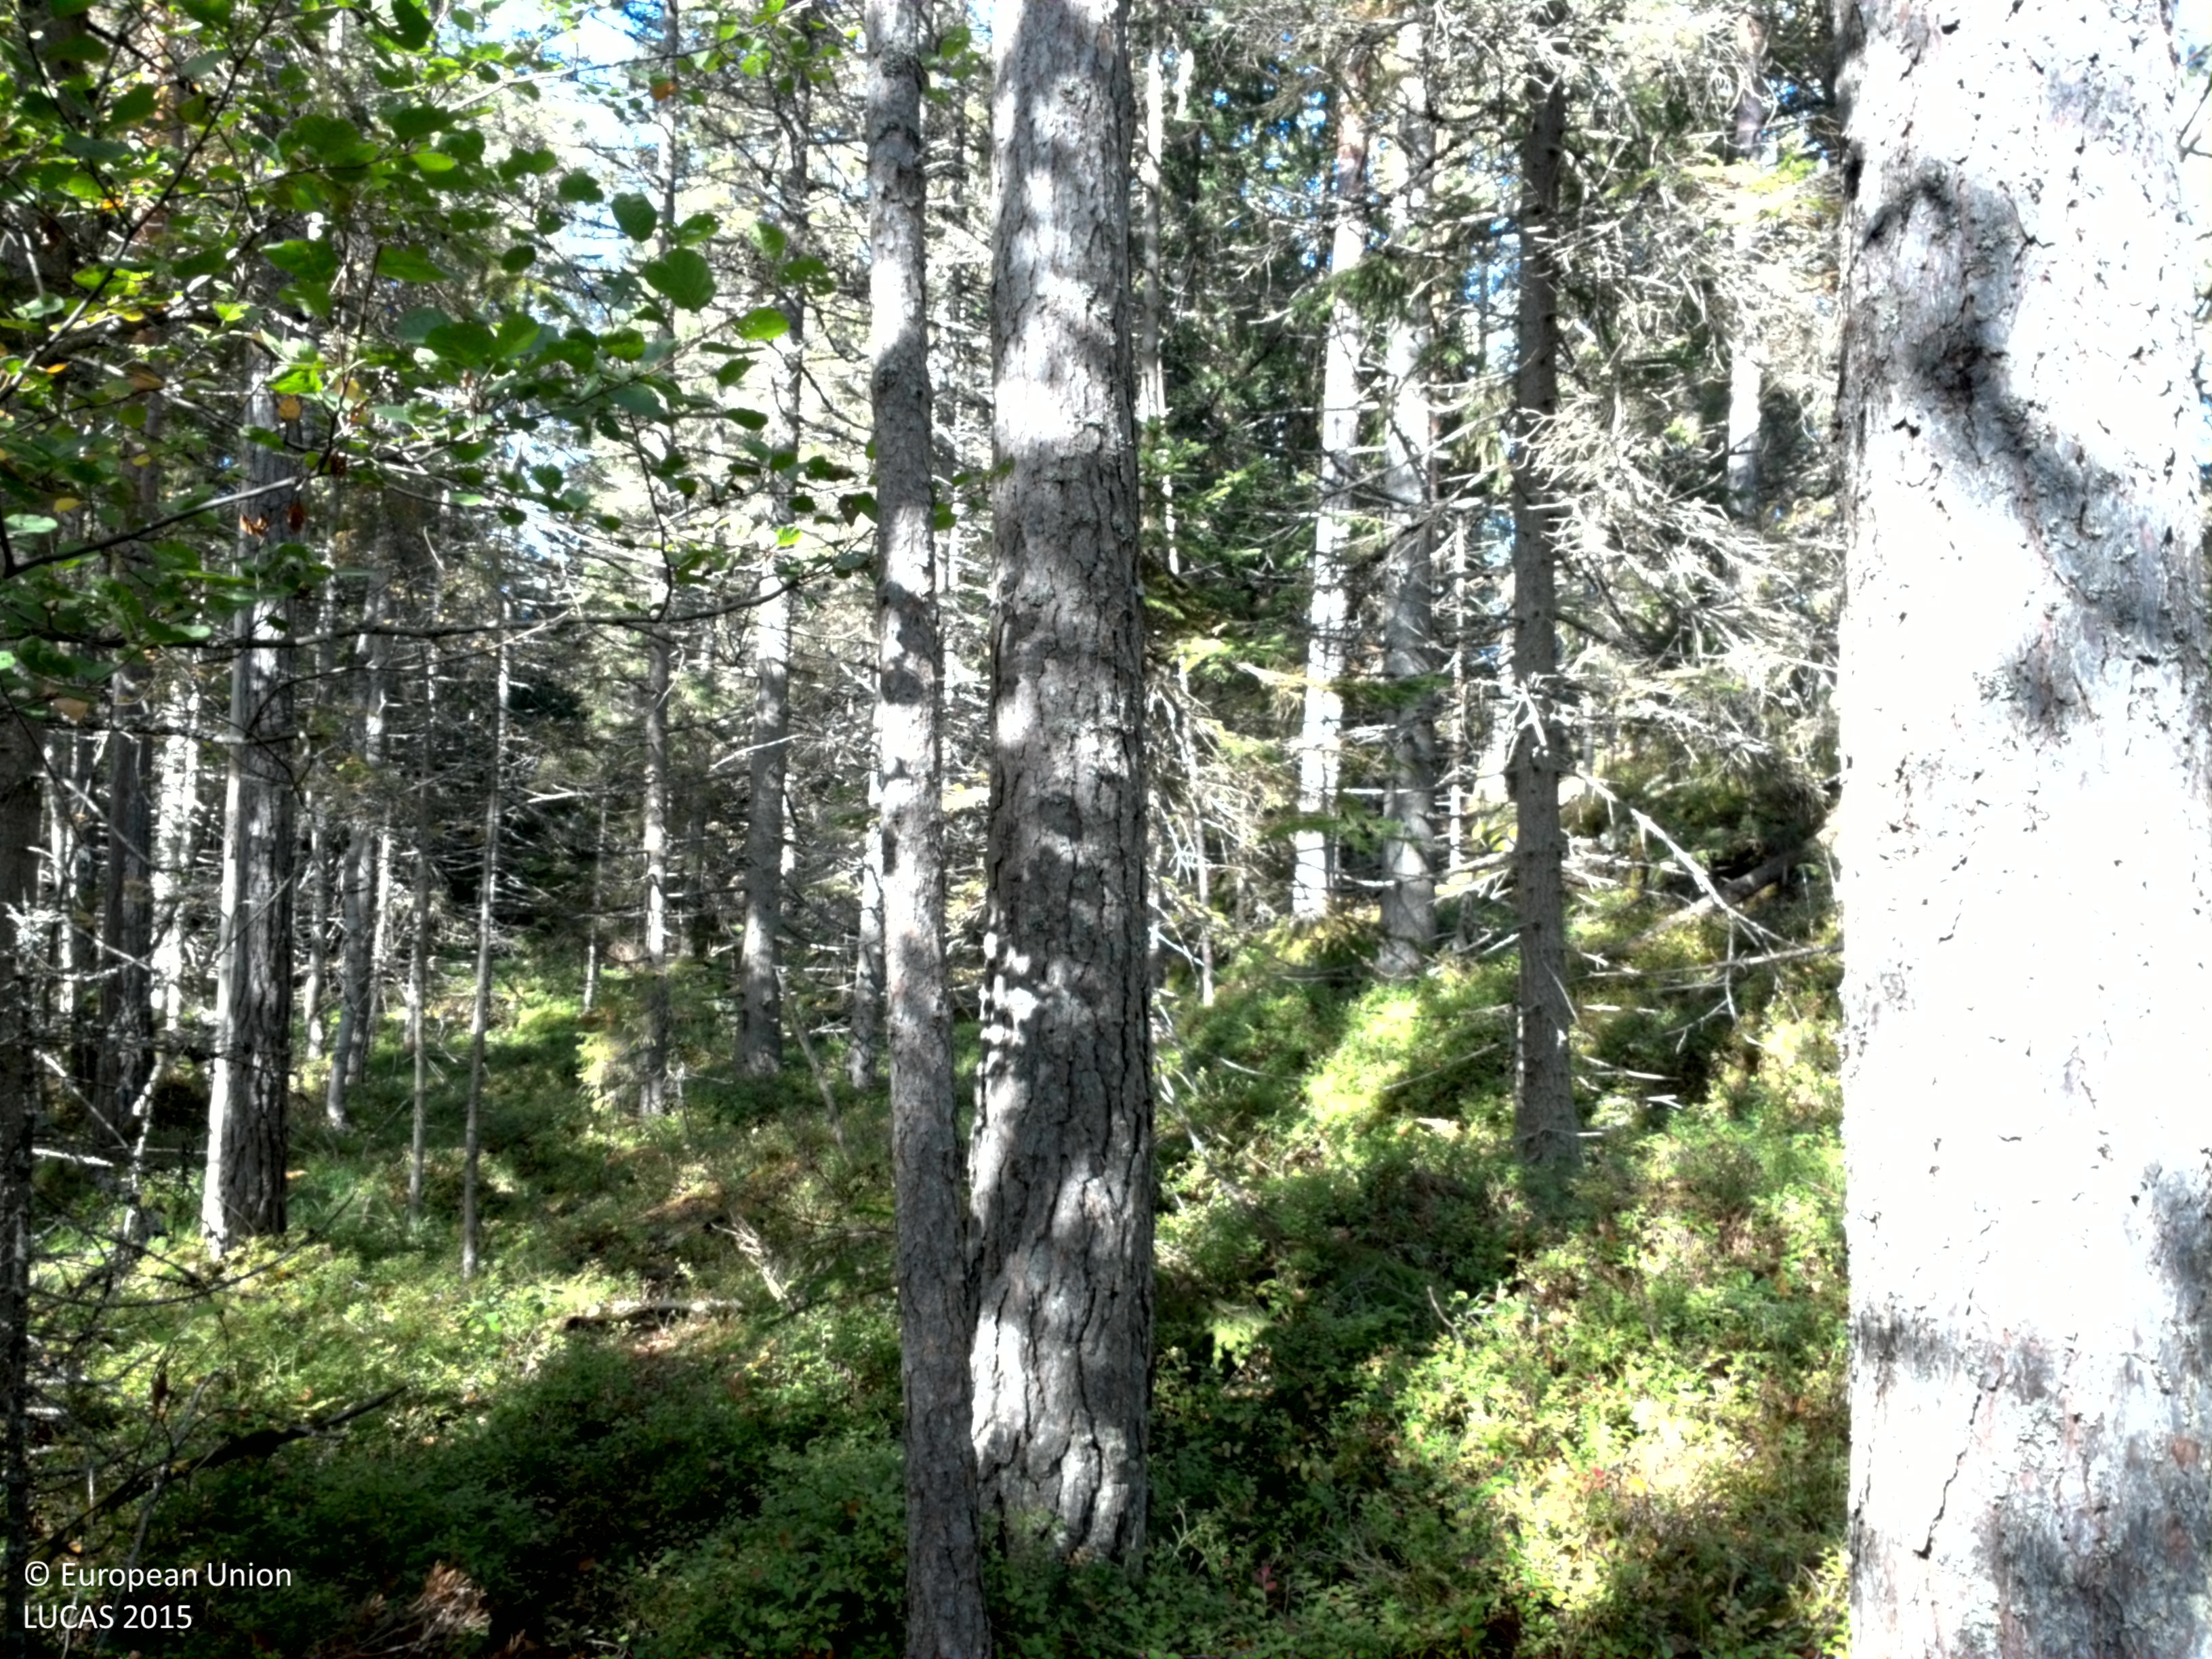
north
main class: Woodland
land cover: Pine dominated mixed woodland
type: boreal forest
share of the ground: 50 - 75 %
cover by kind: coniferous forest trees 45 %, broadleaved forest trees 25 %, shrubs 20 %, lichens and mosses 10 %
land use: Forestry
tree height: > 5 m
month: September
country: SE
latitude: 59.7930
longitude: 18.8568
